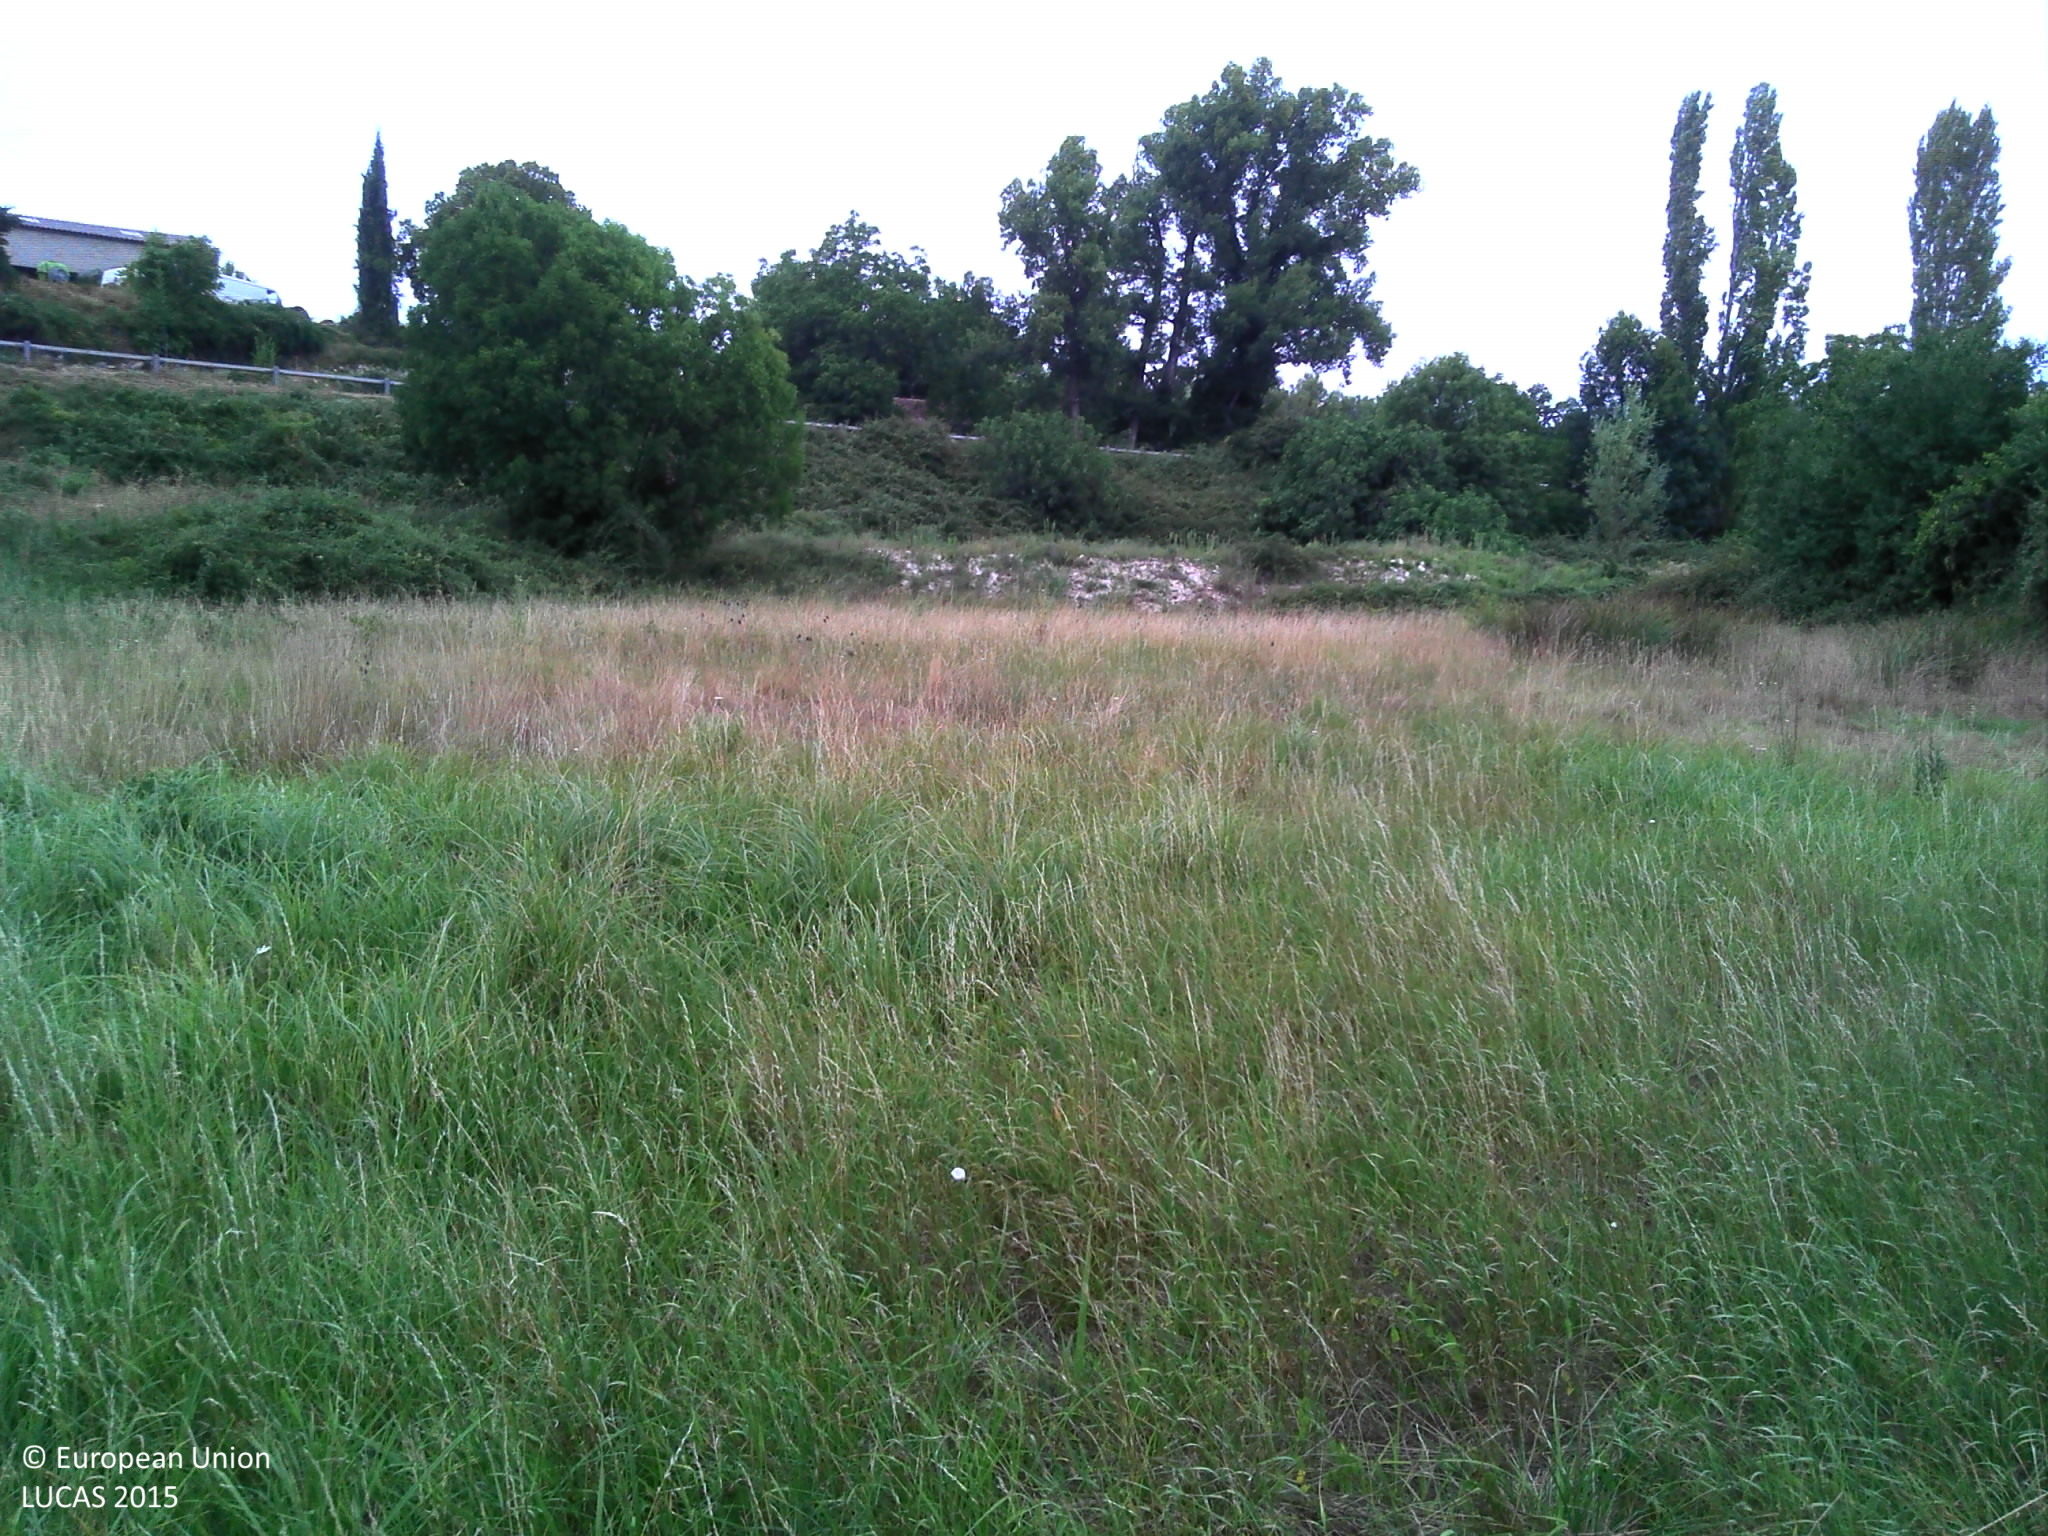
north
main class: Grassland
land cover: Grassland without tree/shrub cover
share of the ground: > 75 %
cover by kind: herbaceous plants 95 %, shrubs 5 %
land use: Agriculture (excluding fallow land and kitchen gardens)
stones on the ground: < 10 %
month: August
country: FR
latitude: 43.8902
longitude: 5.4651
